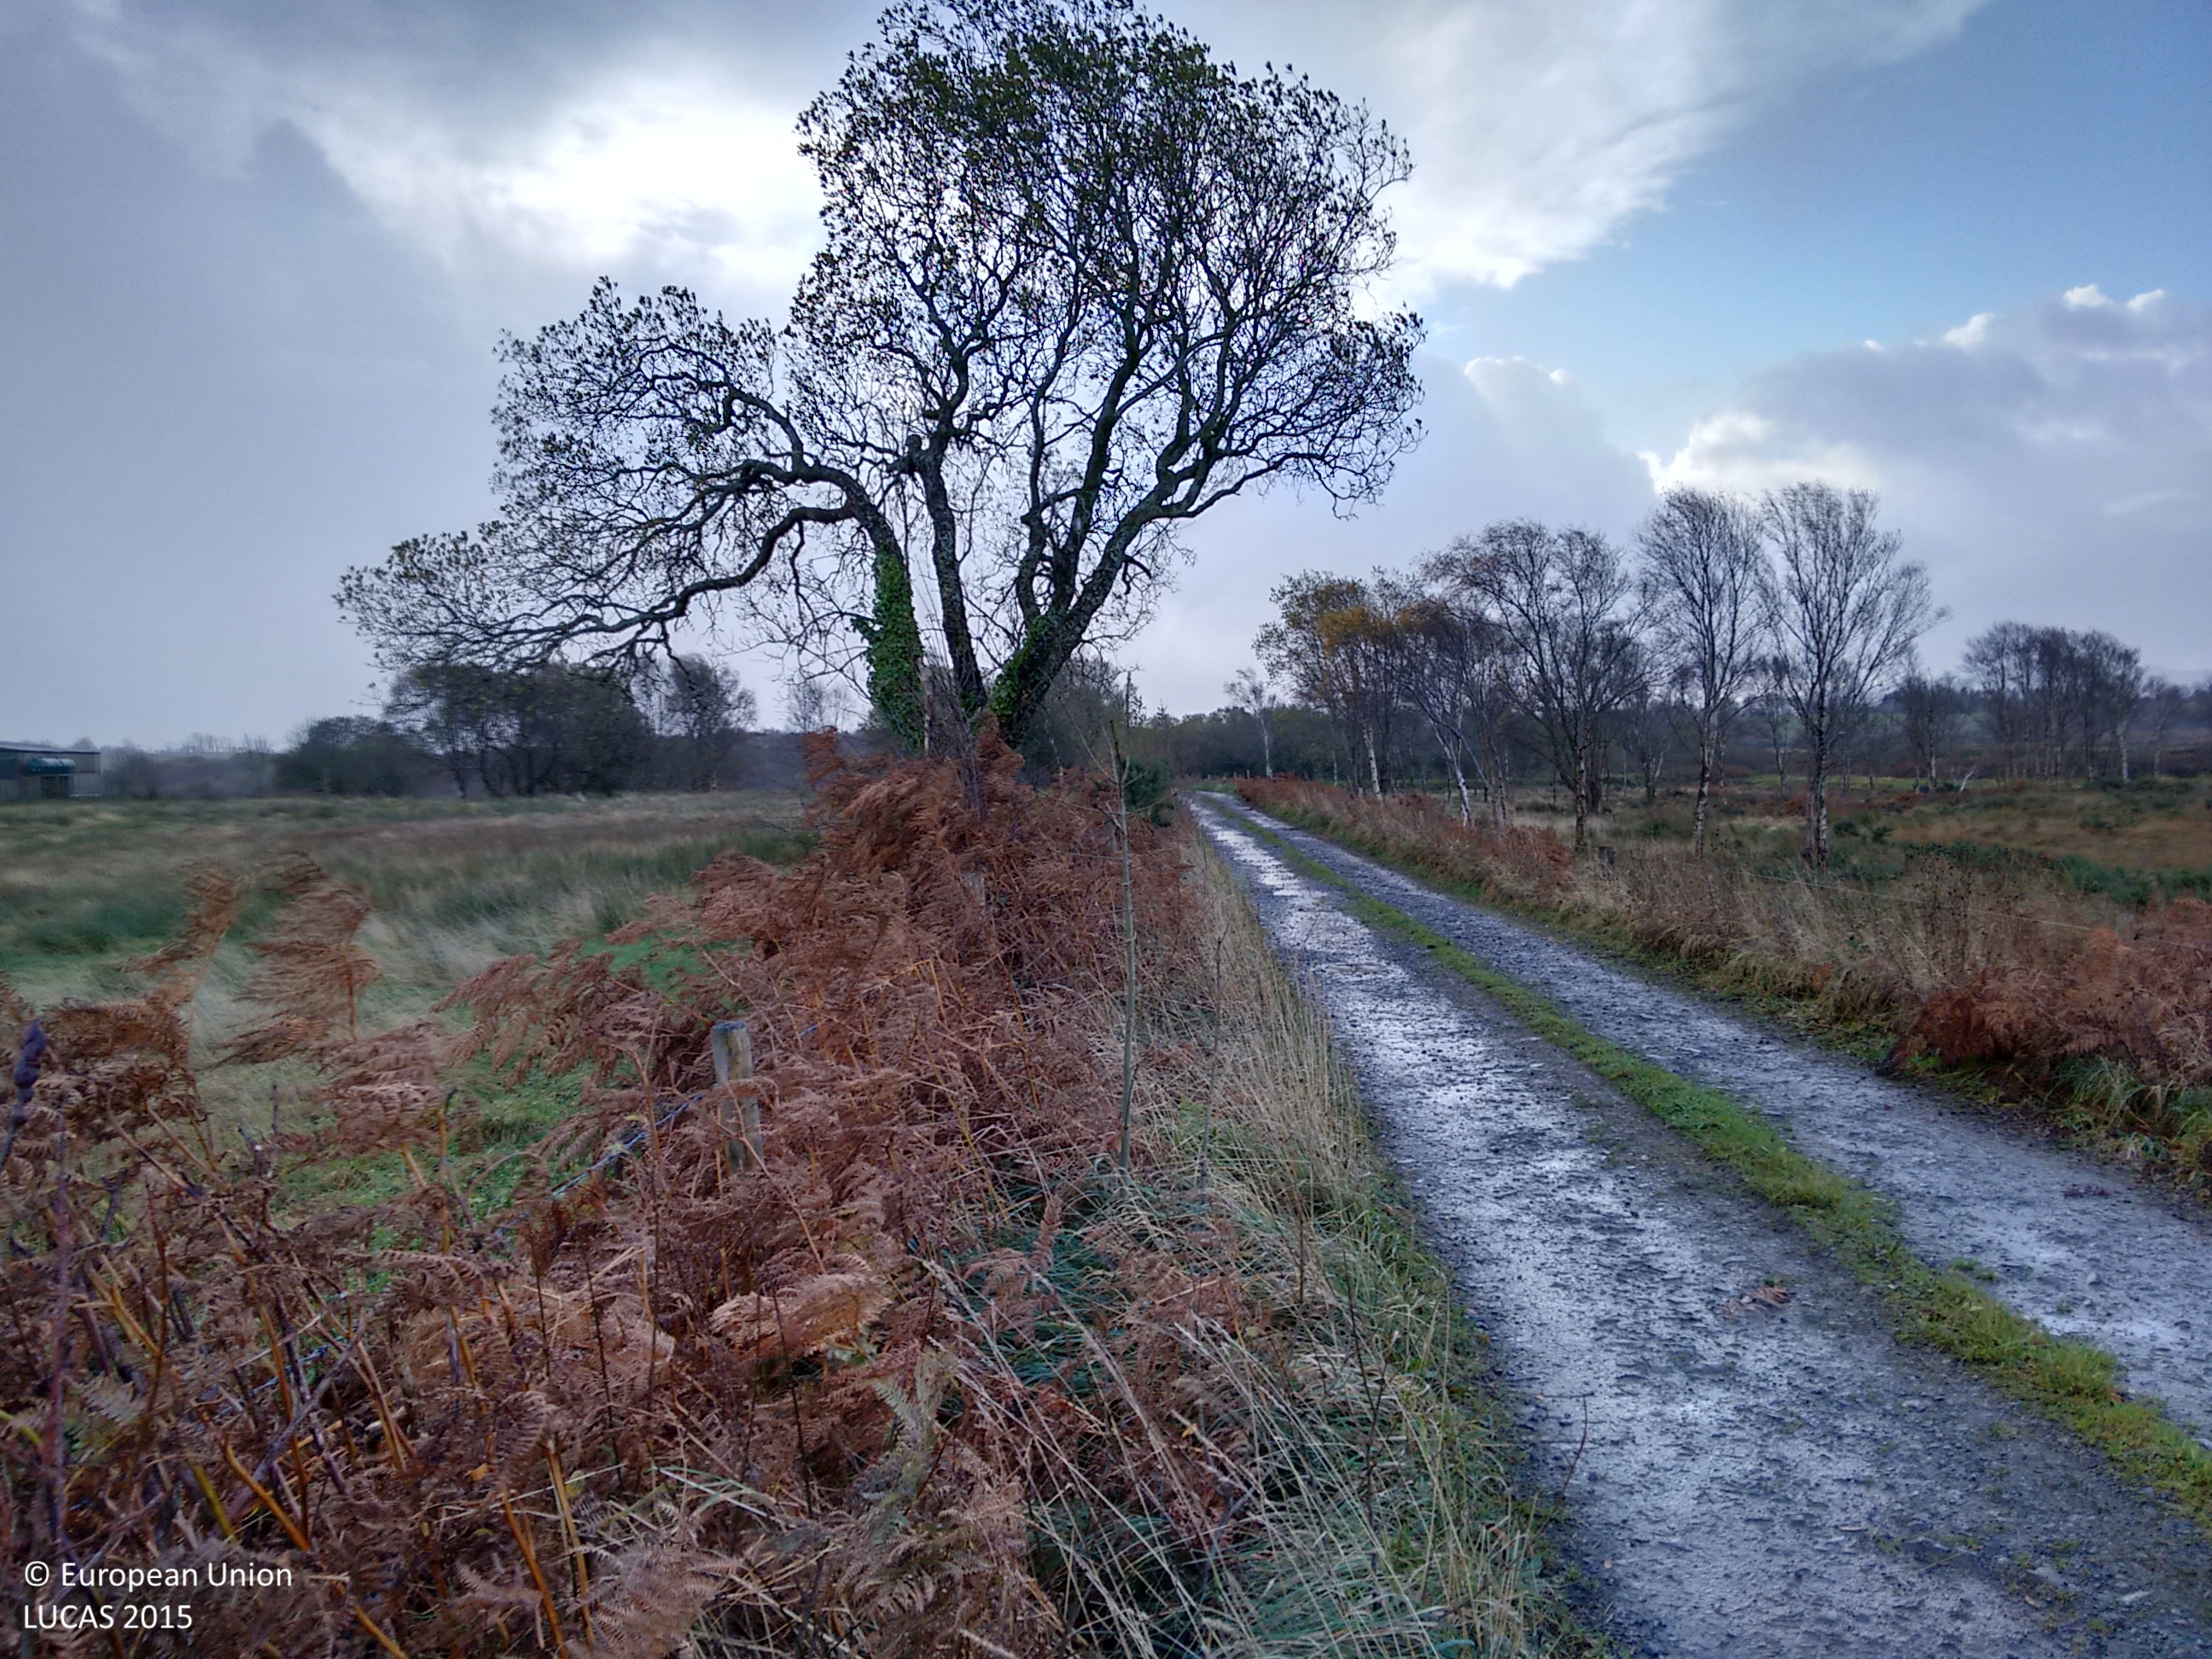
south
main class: Grassland
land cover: Grassland without tree/shrub cover
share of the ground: > 75 %
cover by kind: herbaceous plants 100 %
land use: Agriculture (excluding fallow land and kitchen gardens)
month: November
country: IE
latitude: 54.4732
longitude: -8.1240
